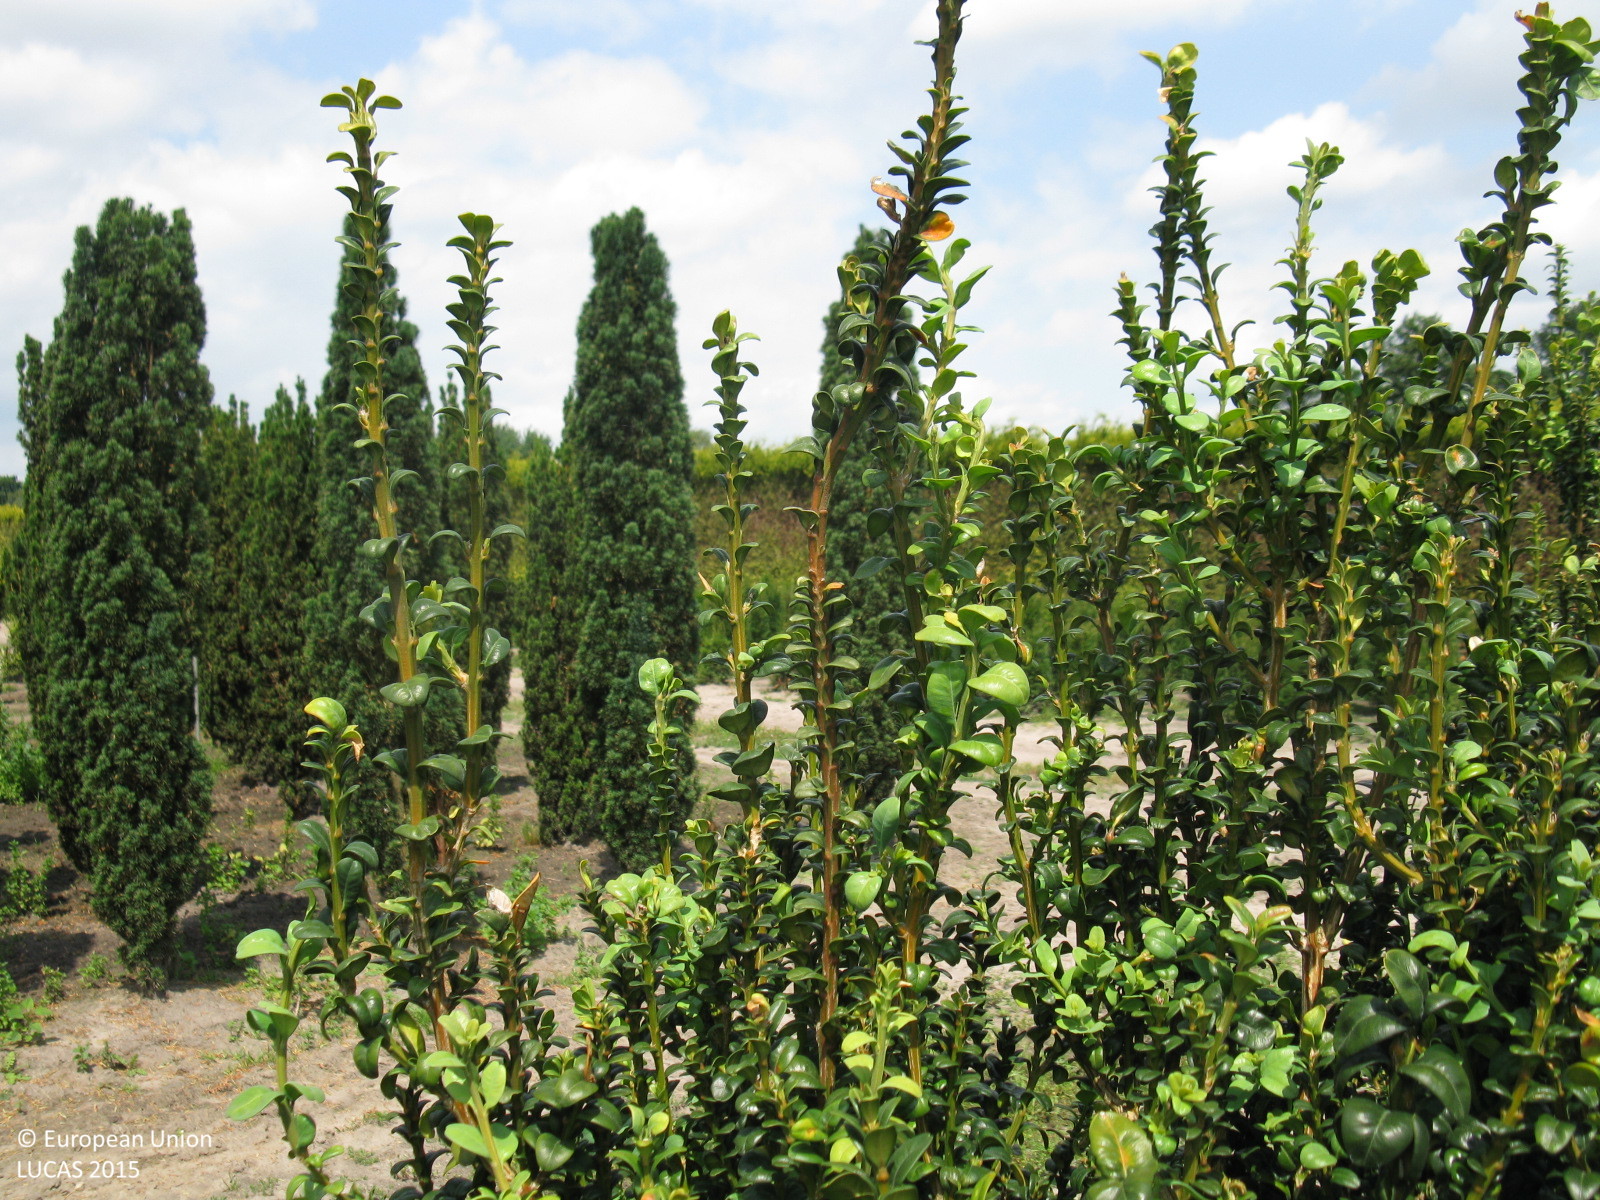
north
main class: Cropland
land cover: Nurseries
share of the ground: > 75 %
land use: Agriculture (excluding fallow land and kitchen gardens)
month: July
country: DE
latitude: 53.3300
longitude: 7.9135
